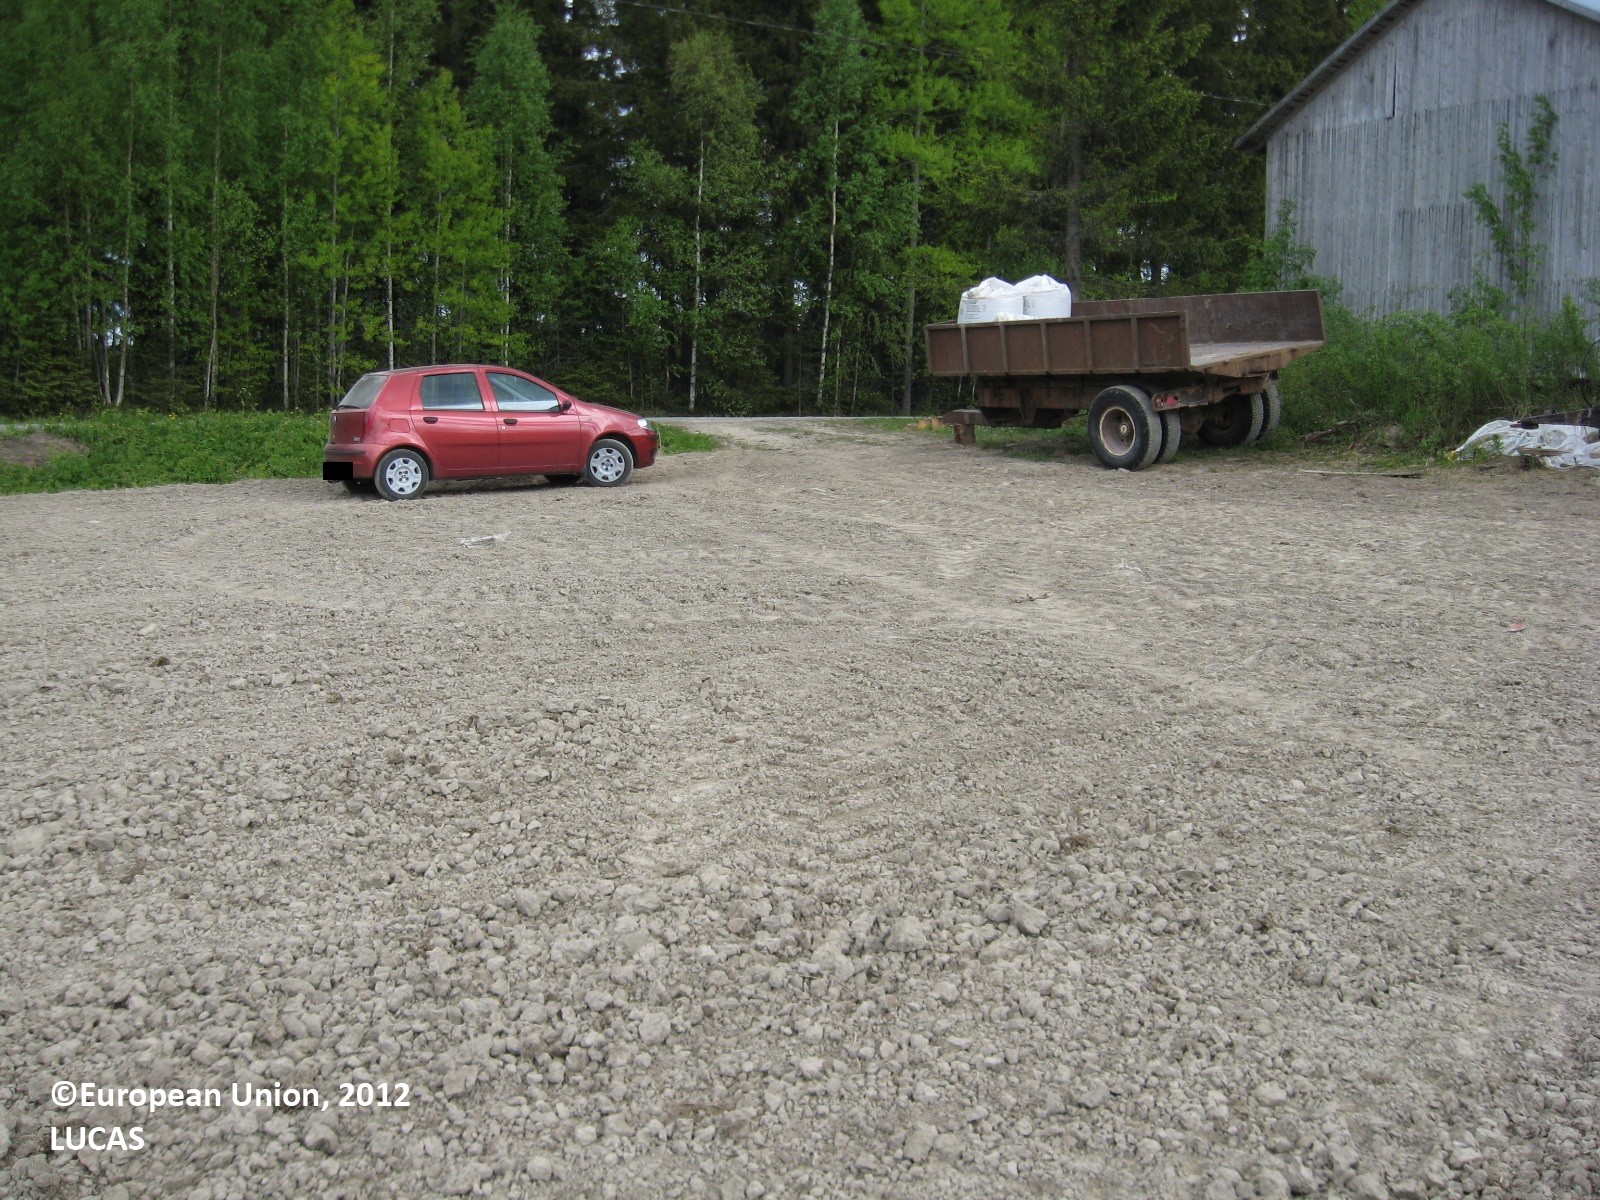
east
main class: Cropland
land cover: Oats
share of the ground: < 10 %
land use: Agriculture (excluding fallow land and kitchen gardens)
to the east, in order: Oats; Ditches and canals; Grass margins; Paved roads, cycling and walking lanes; Ditches and canals; Lines of trees; Spruce dominated coniferous woodland; Ditches and canals; Temporary grasslands
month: May
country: FI
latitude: 61.8267
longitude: 22.5739
